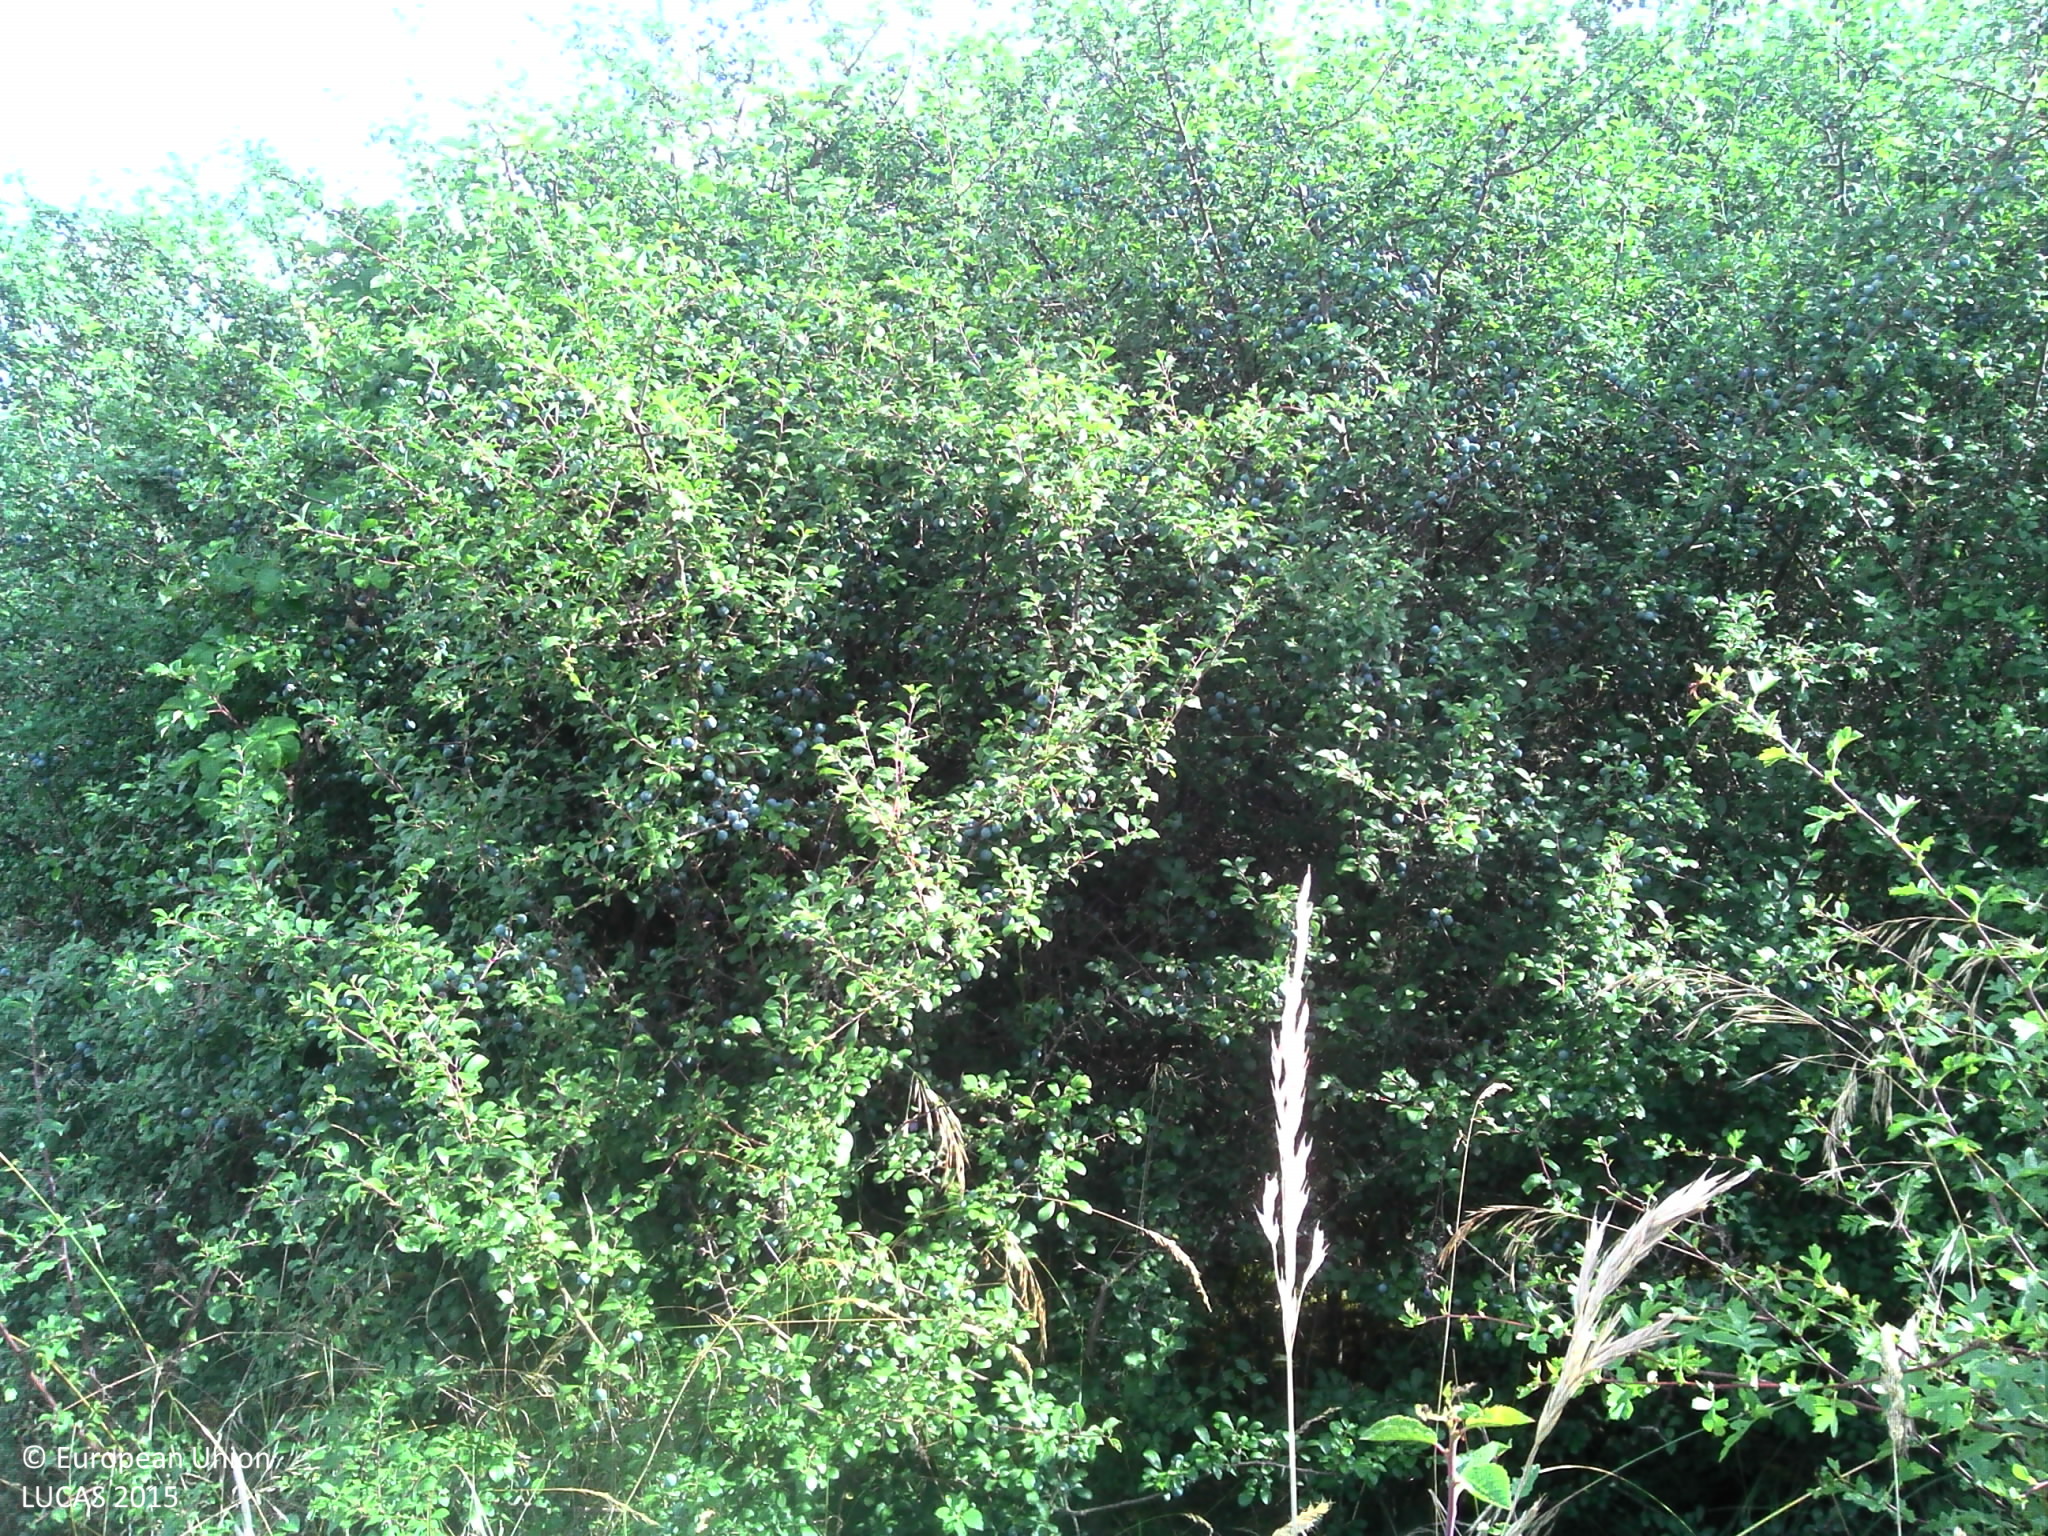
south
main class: Shrubland
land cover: Shrubland with sparse tree cover
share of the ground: > 75 %
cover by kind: shrubs 95 %, broadleaved forest trees 5 %
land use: Abandoned areas
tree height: < 5 m
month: June
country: FR
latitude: 44.0896
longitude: 1.9213
